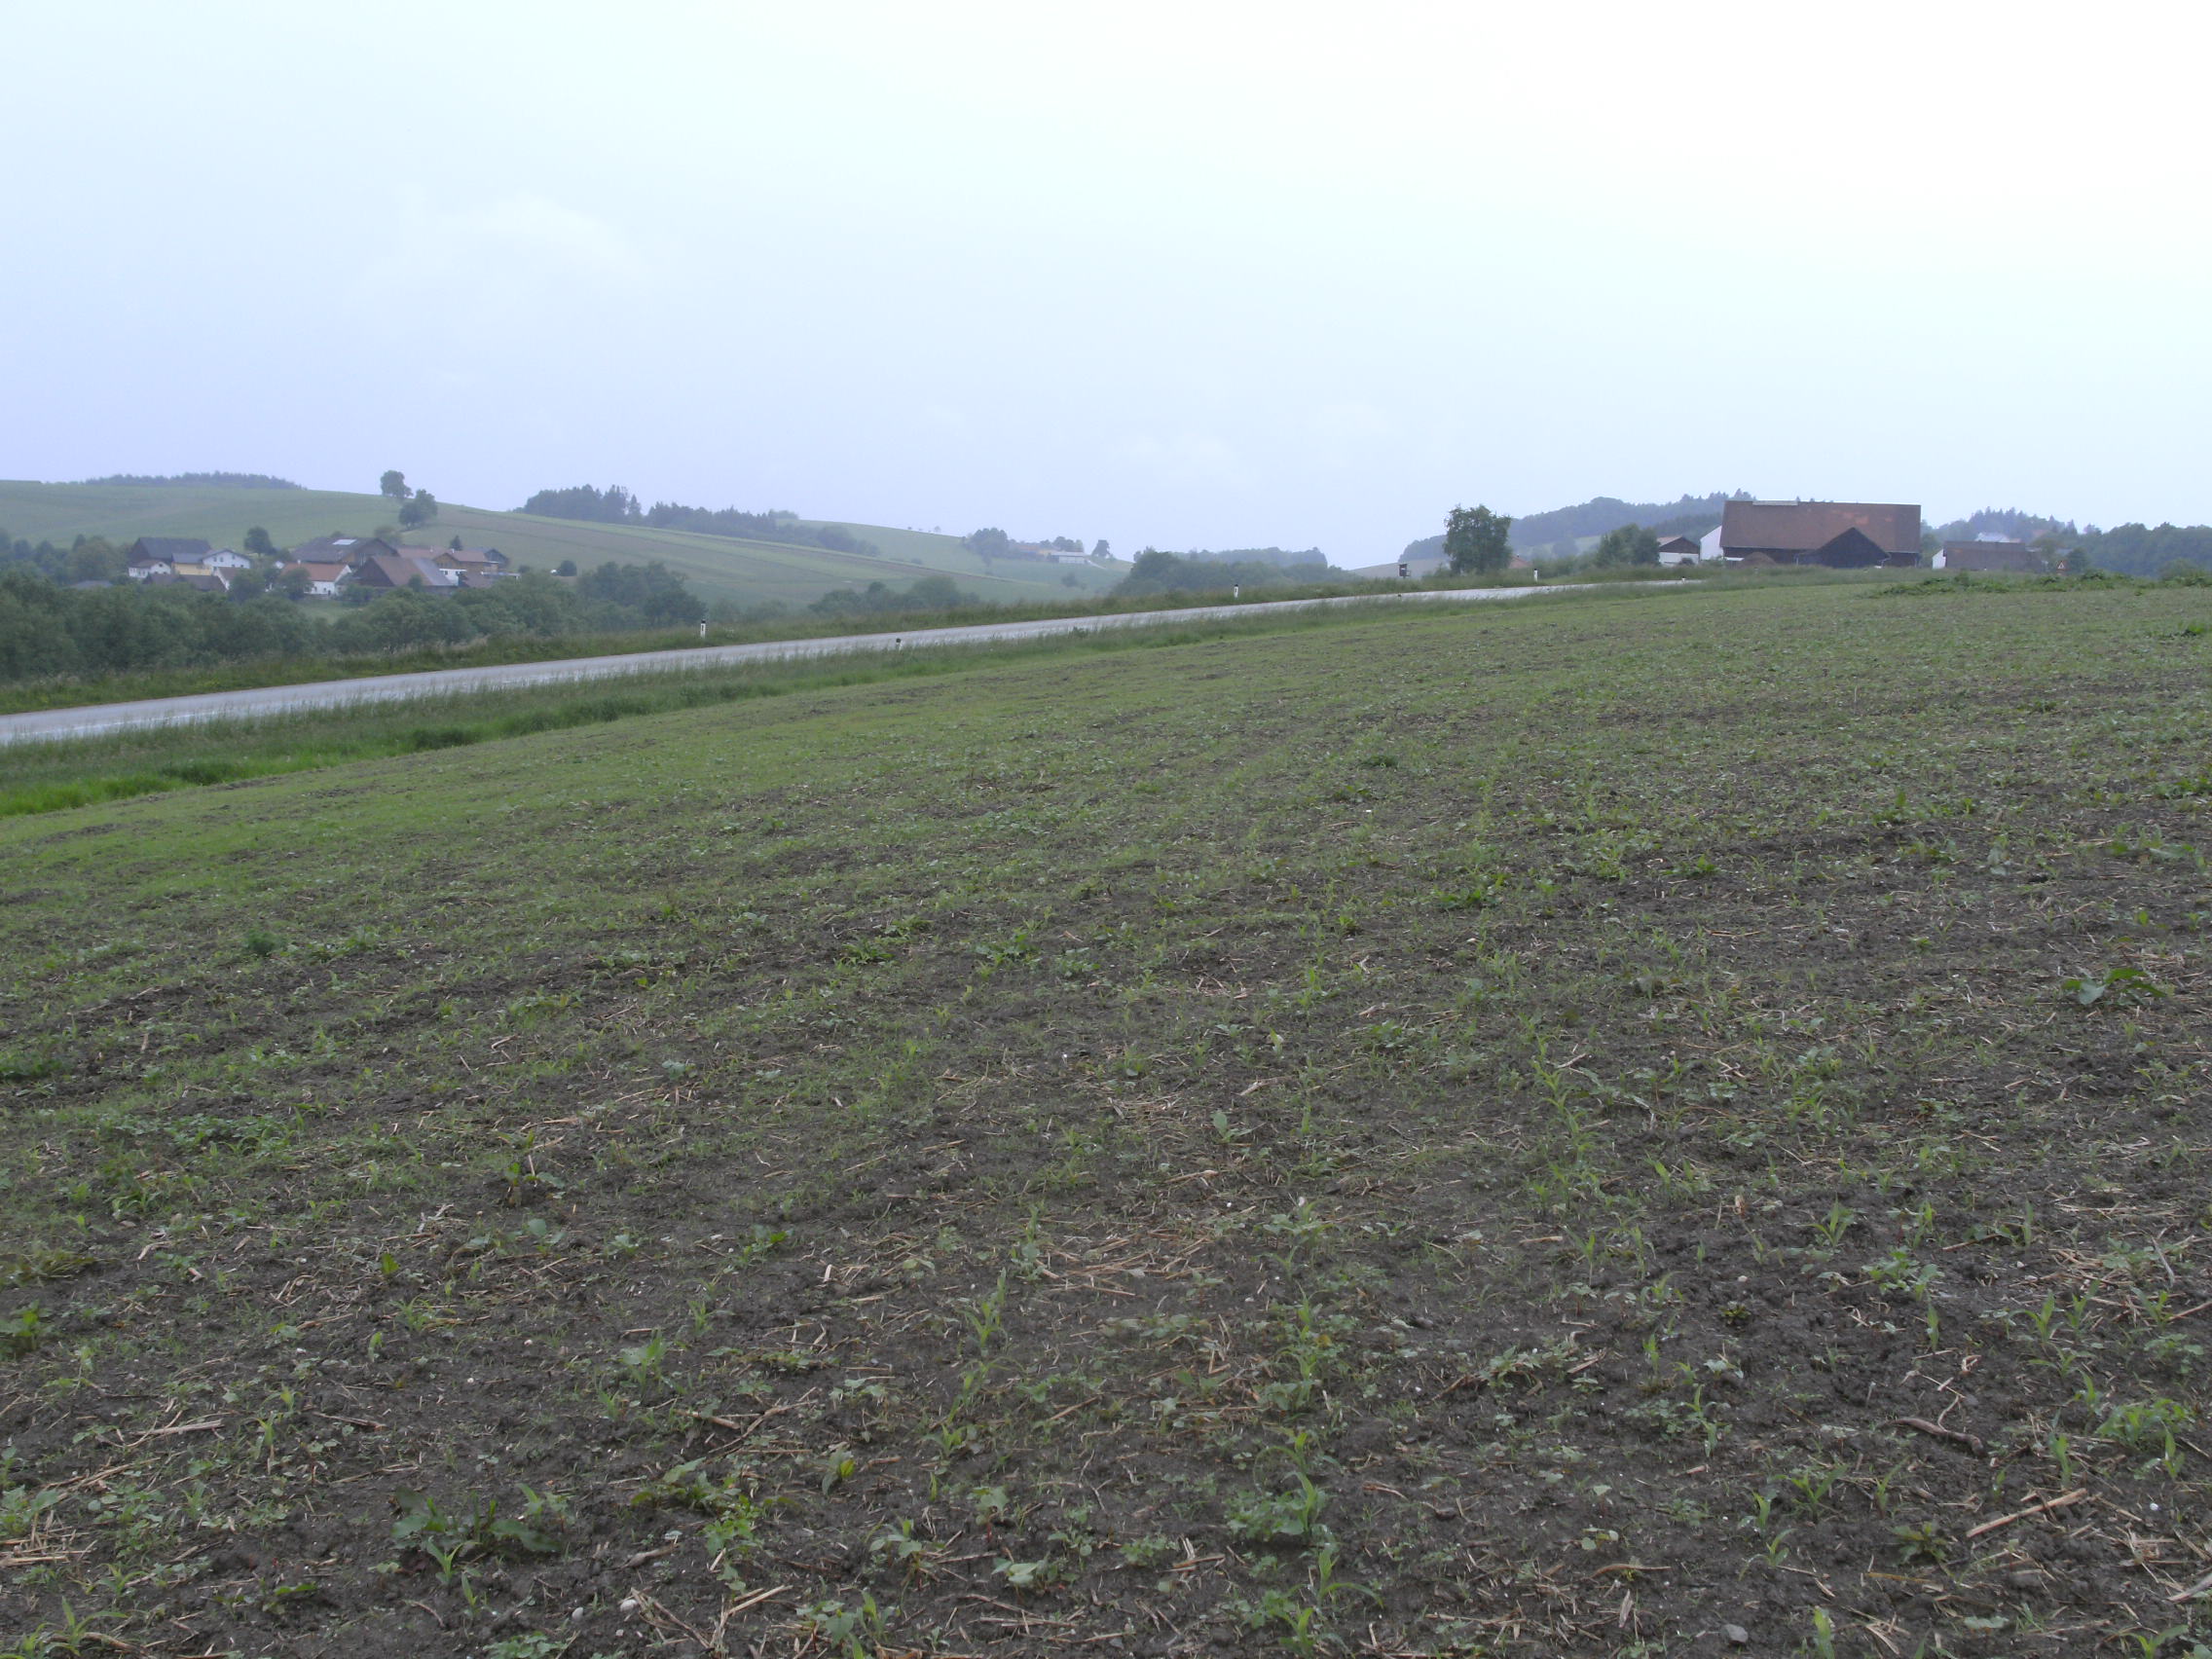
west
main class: Cropland
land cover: Maize
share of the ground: < 10 %
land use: Agriculture (excluding fallow land and kitchen gardens)
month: May
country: AT
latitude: 48.3295
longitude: 13.5199
